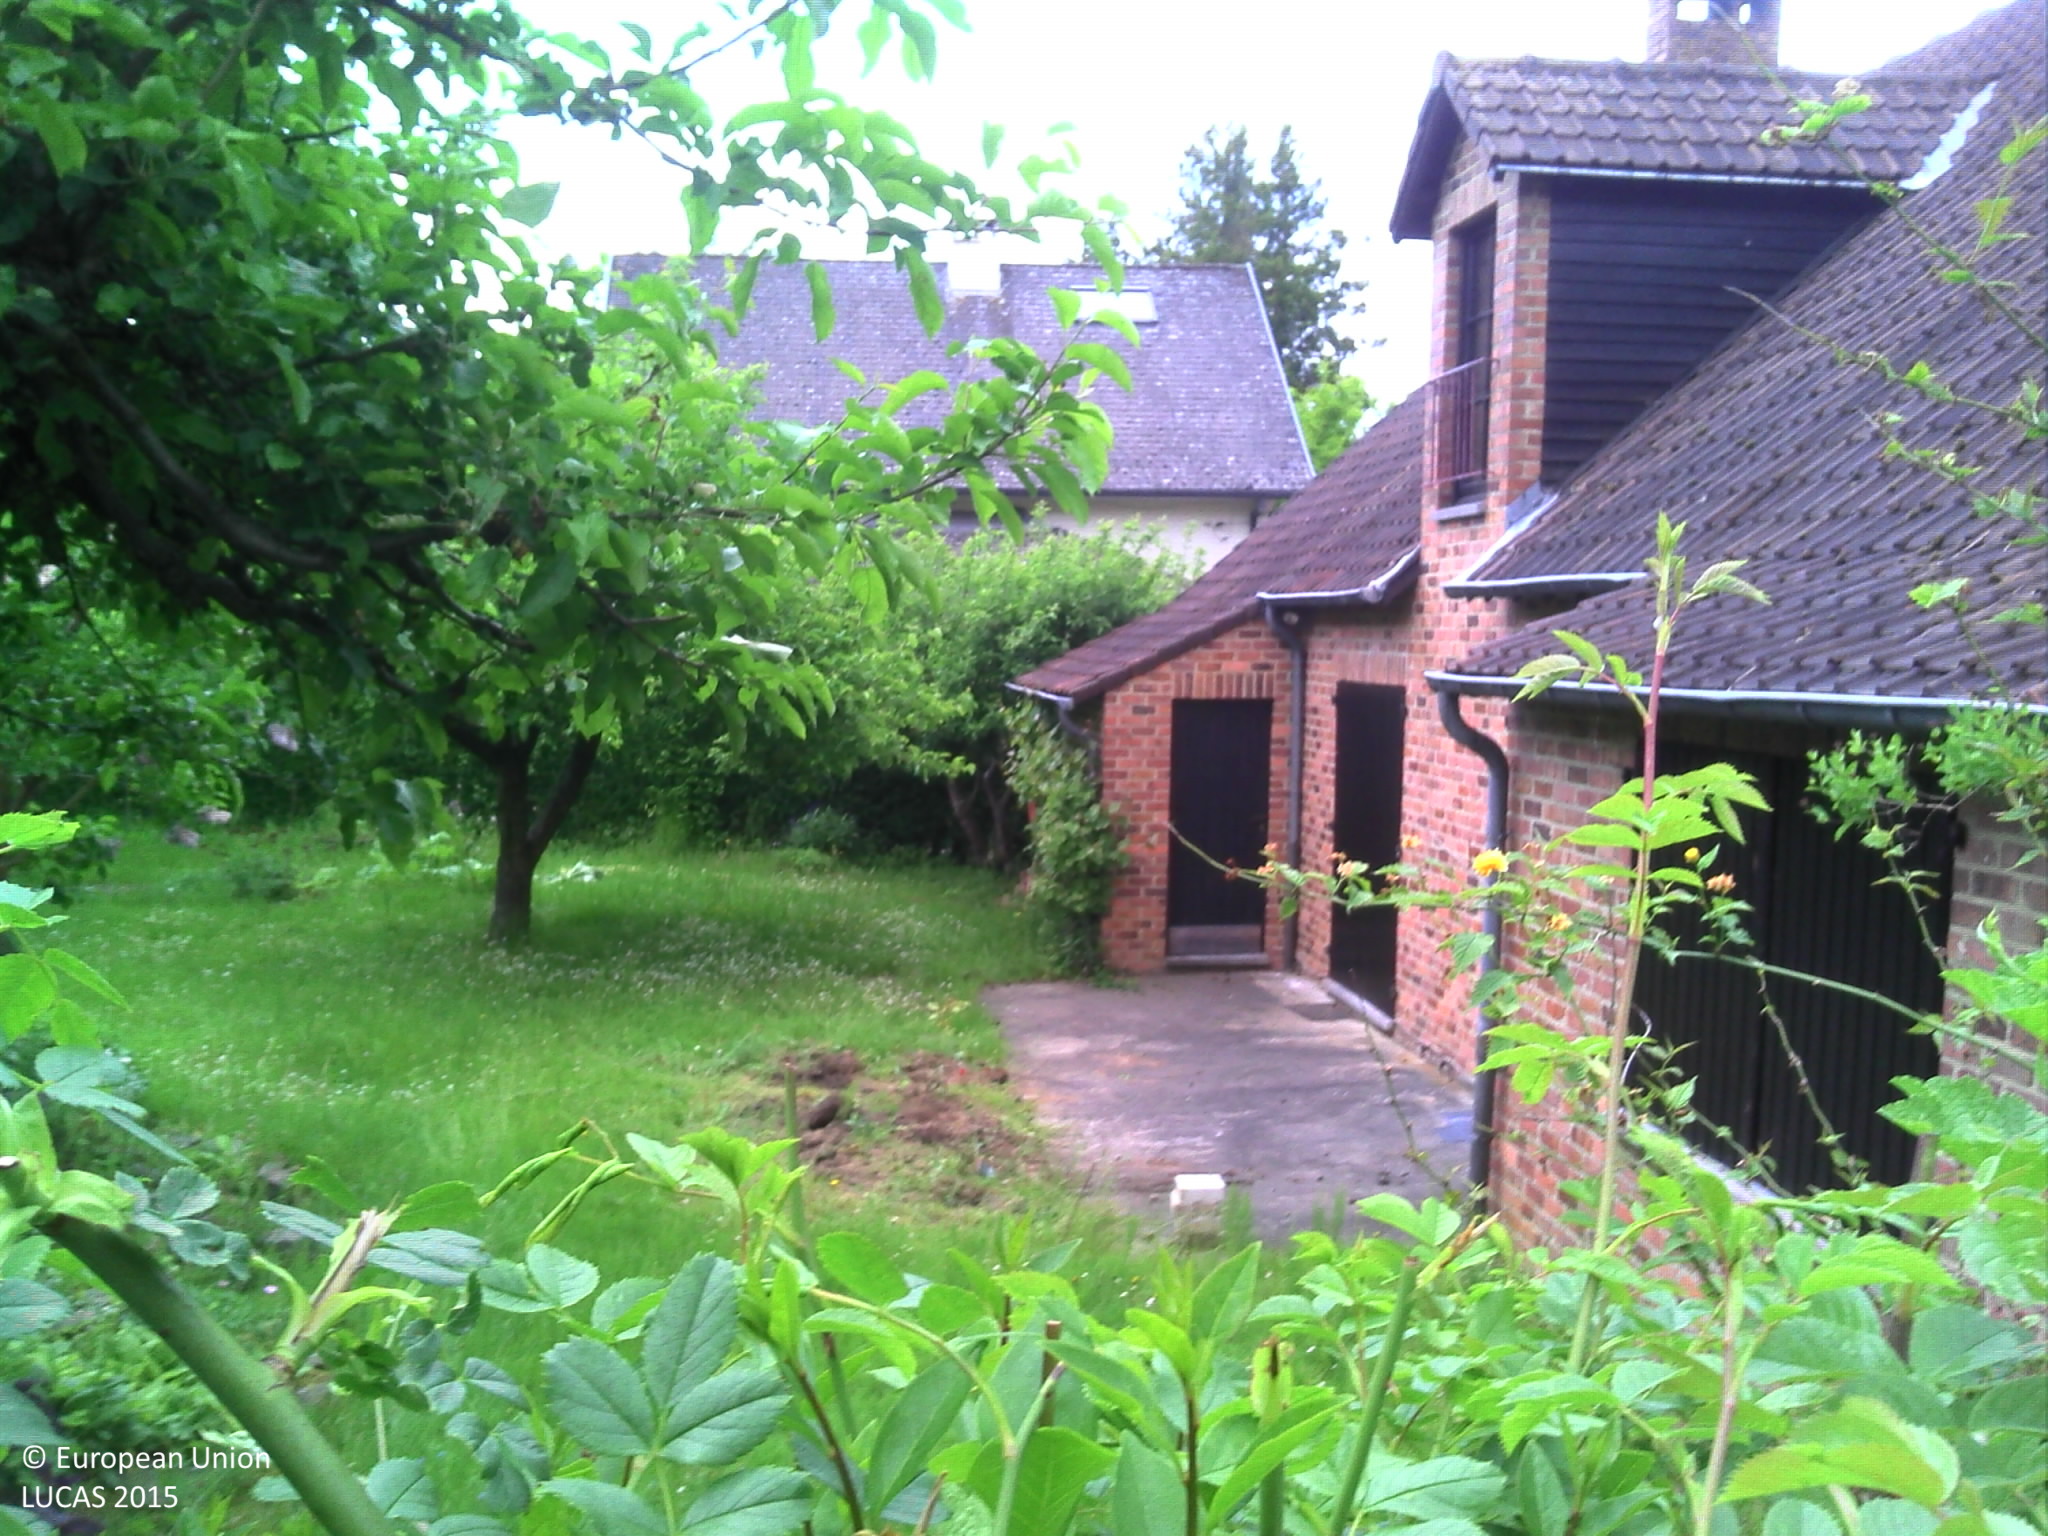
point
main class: Grassland
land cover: Grassland with sparse tree/shrub cover
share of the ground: > 75 %
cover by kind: herbaceous plants 95 %, broadleaved forest trees 5 %
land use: Residential
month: May
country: BE
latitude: 50.7177
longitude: 4.4861
